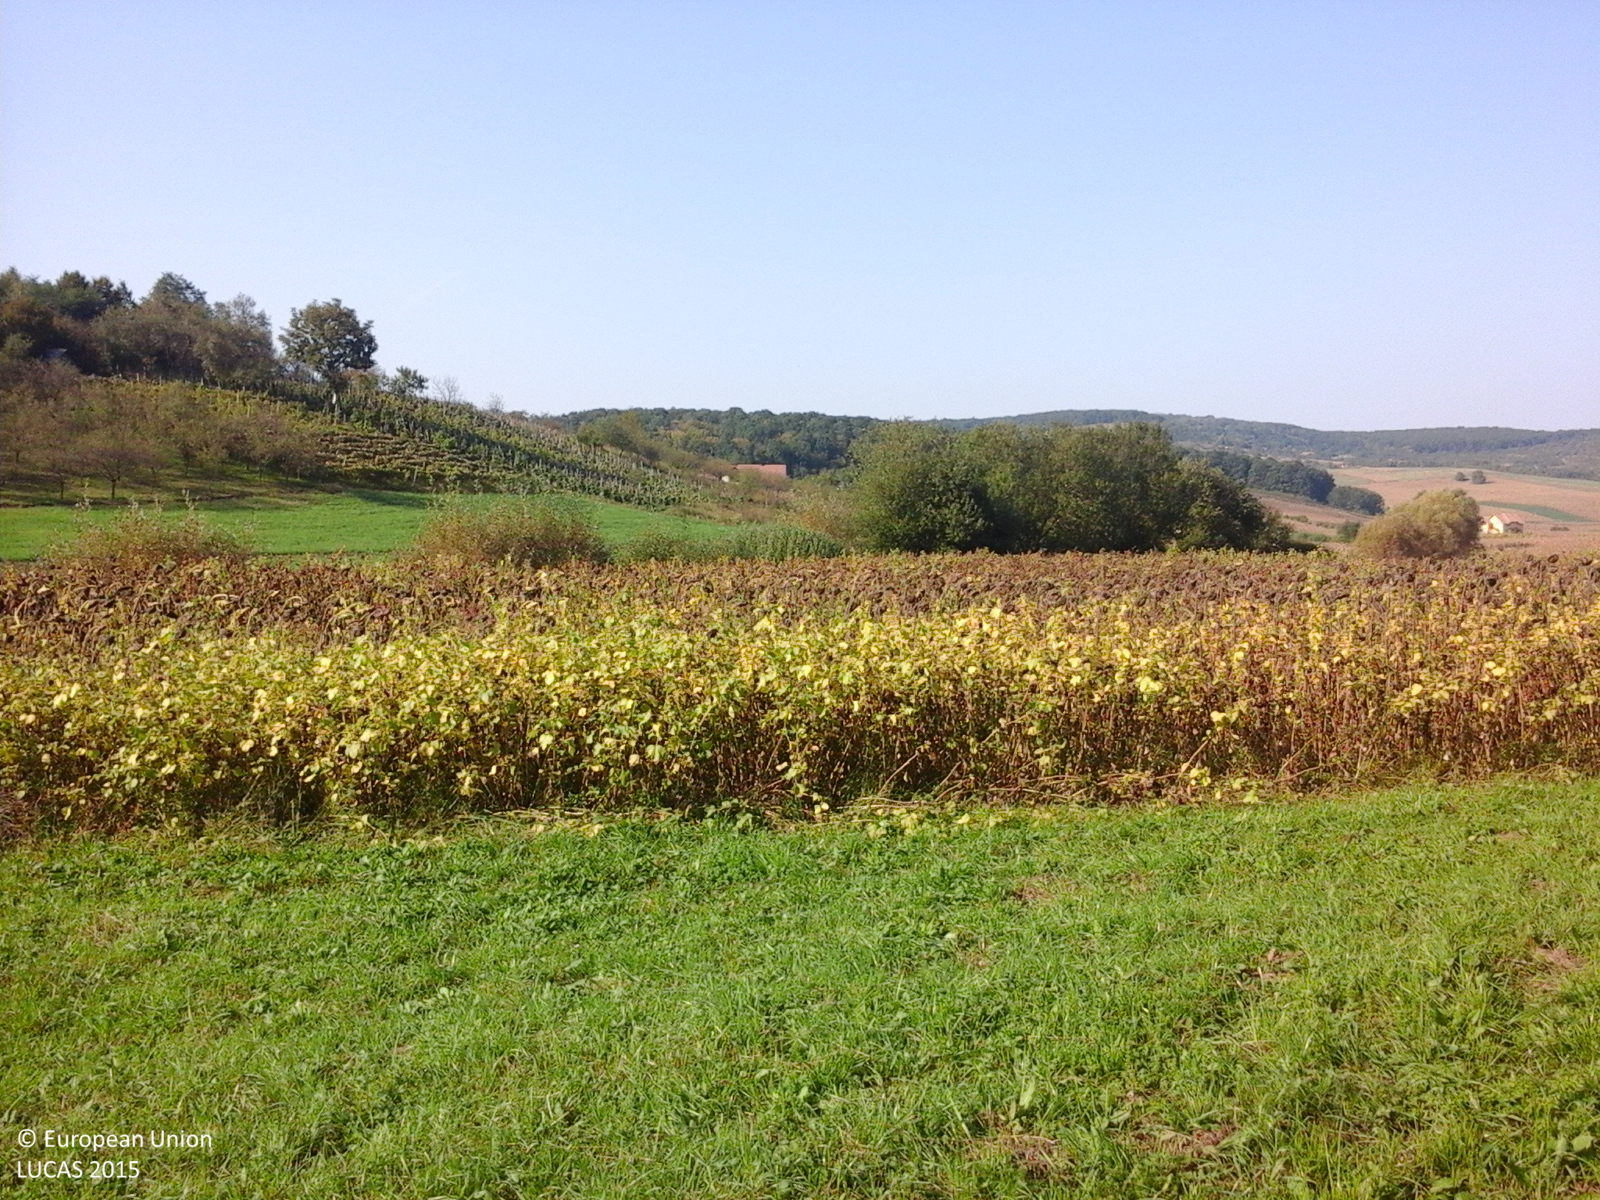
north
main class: Grassland
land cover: Grassland without tree/shrub cover
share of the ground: > 75 %
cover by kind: herbaceous plants 100 %
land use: Agriculture (excluding fallow land and kitchen gardens)
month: September
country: RO
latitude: 47.2629
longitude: 22.7335
